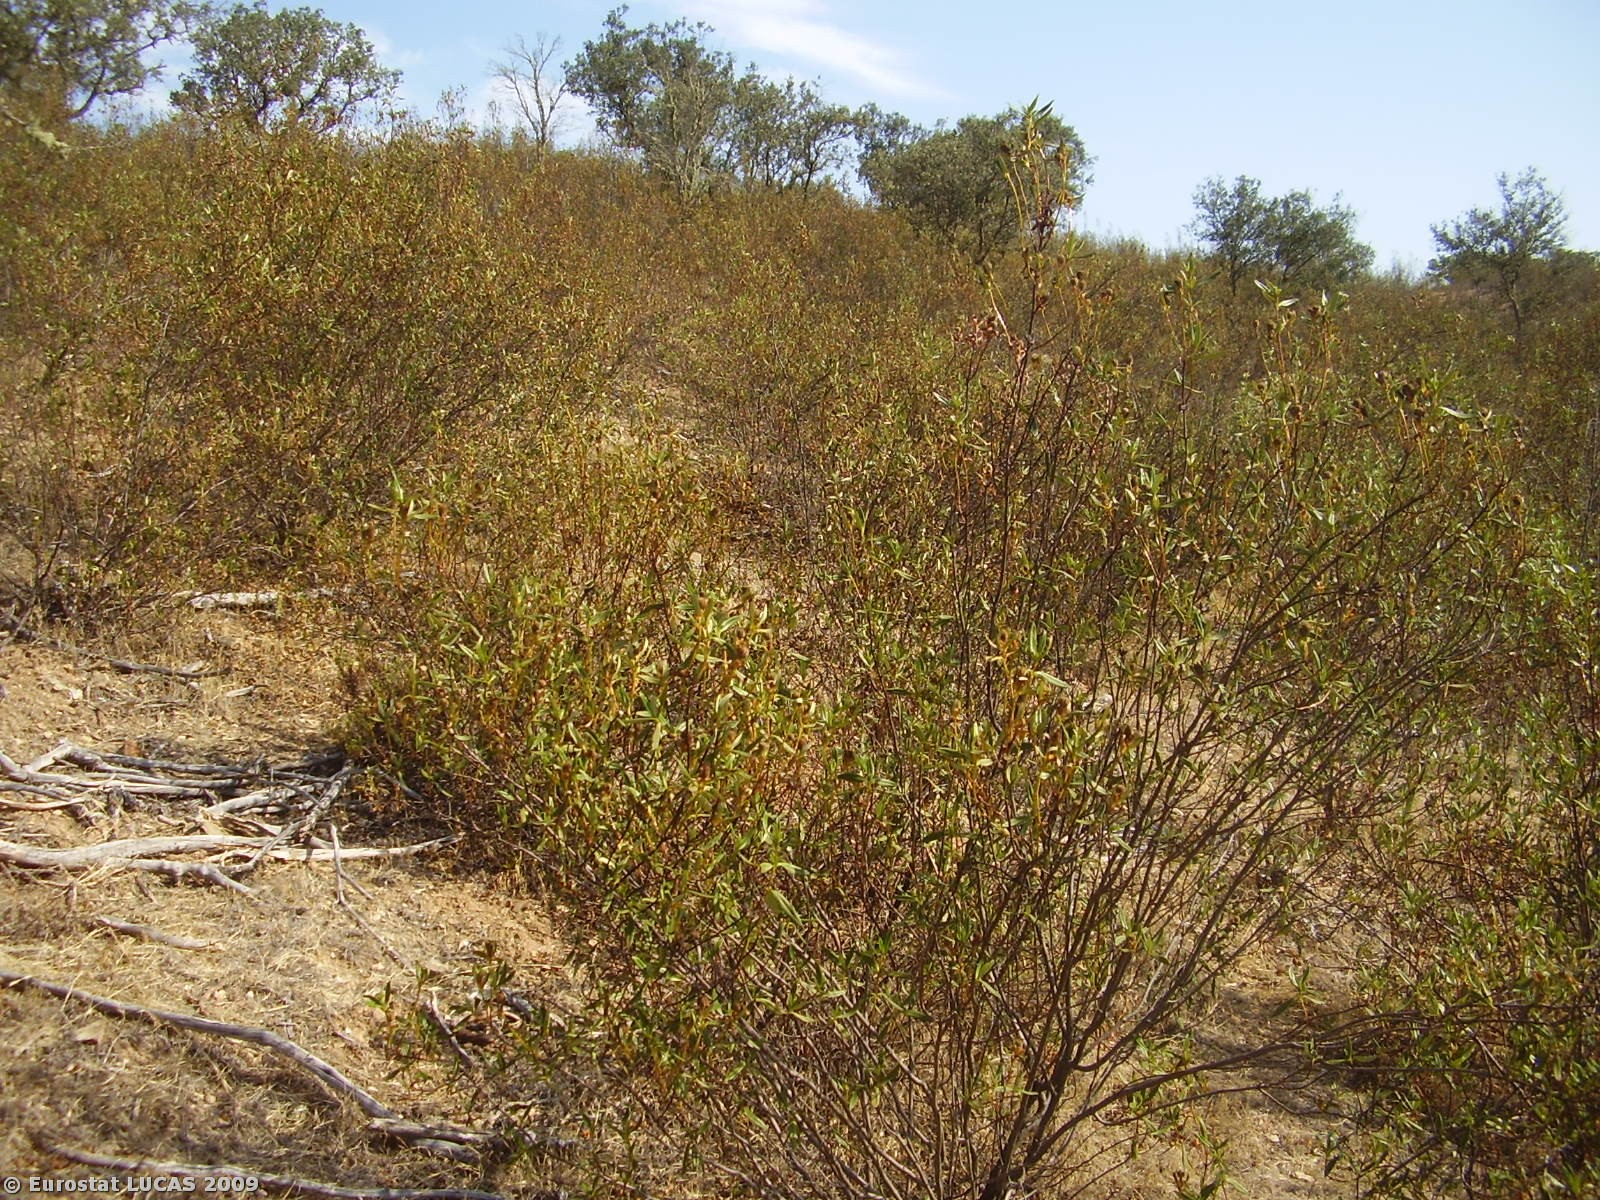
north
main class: Shrubland
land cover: Shrubland with sparse tree cover
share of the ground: 50 - 75 %
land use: Forestry
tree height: > 5 m
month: August
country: PT
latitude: 37.5598
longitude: -8.2422
